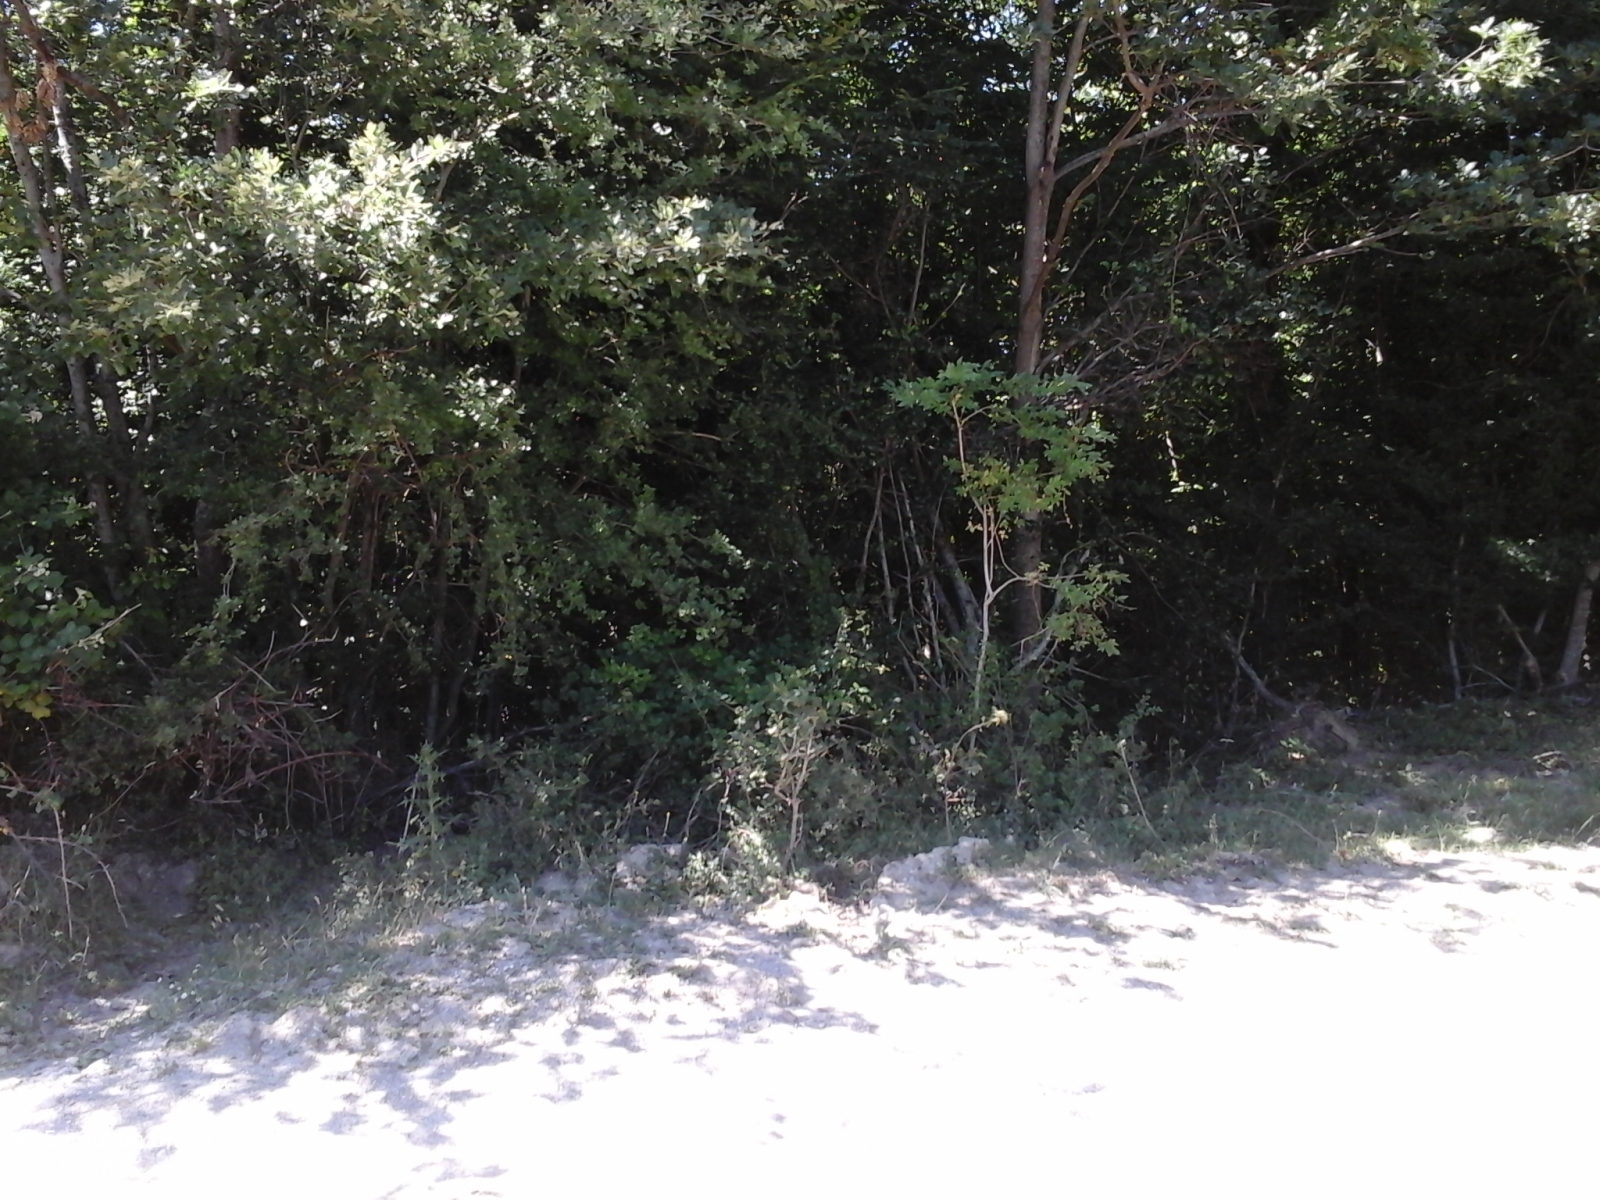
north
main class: Woodland
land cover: Broadleaved woodland
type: thermophilous deciduous forest
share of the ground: > 75 %
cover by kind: broadleaved forest trees 100 %
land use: Forestry
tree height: > 5 m
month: July
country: IT
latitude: 41.6570
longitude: 14.7273
